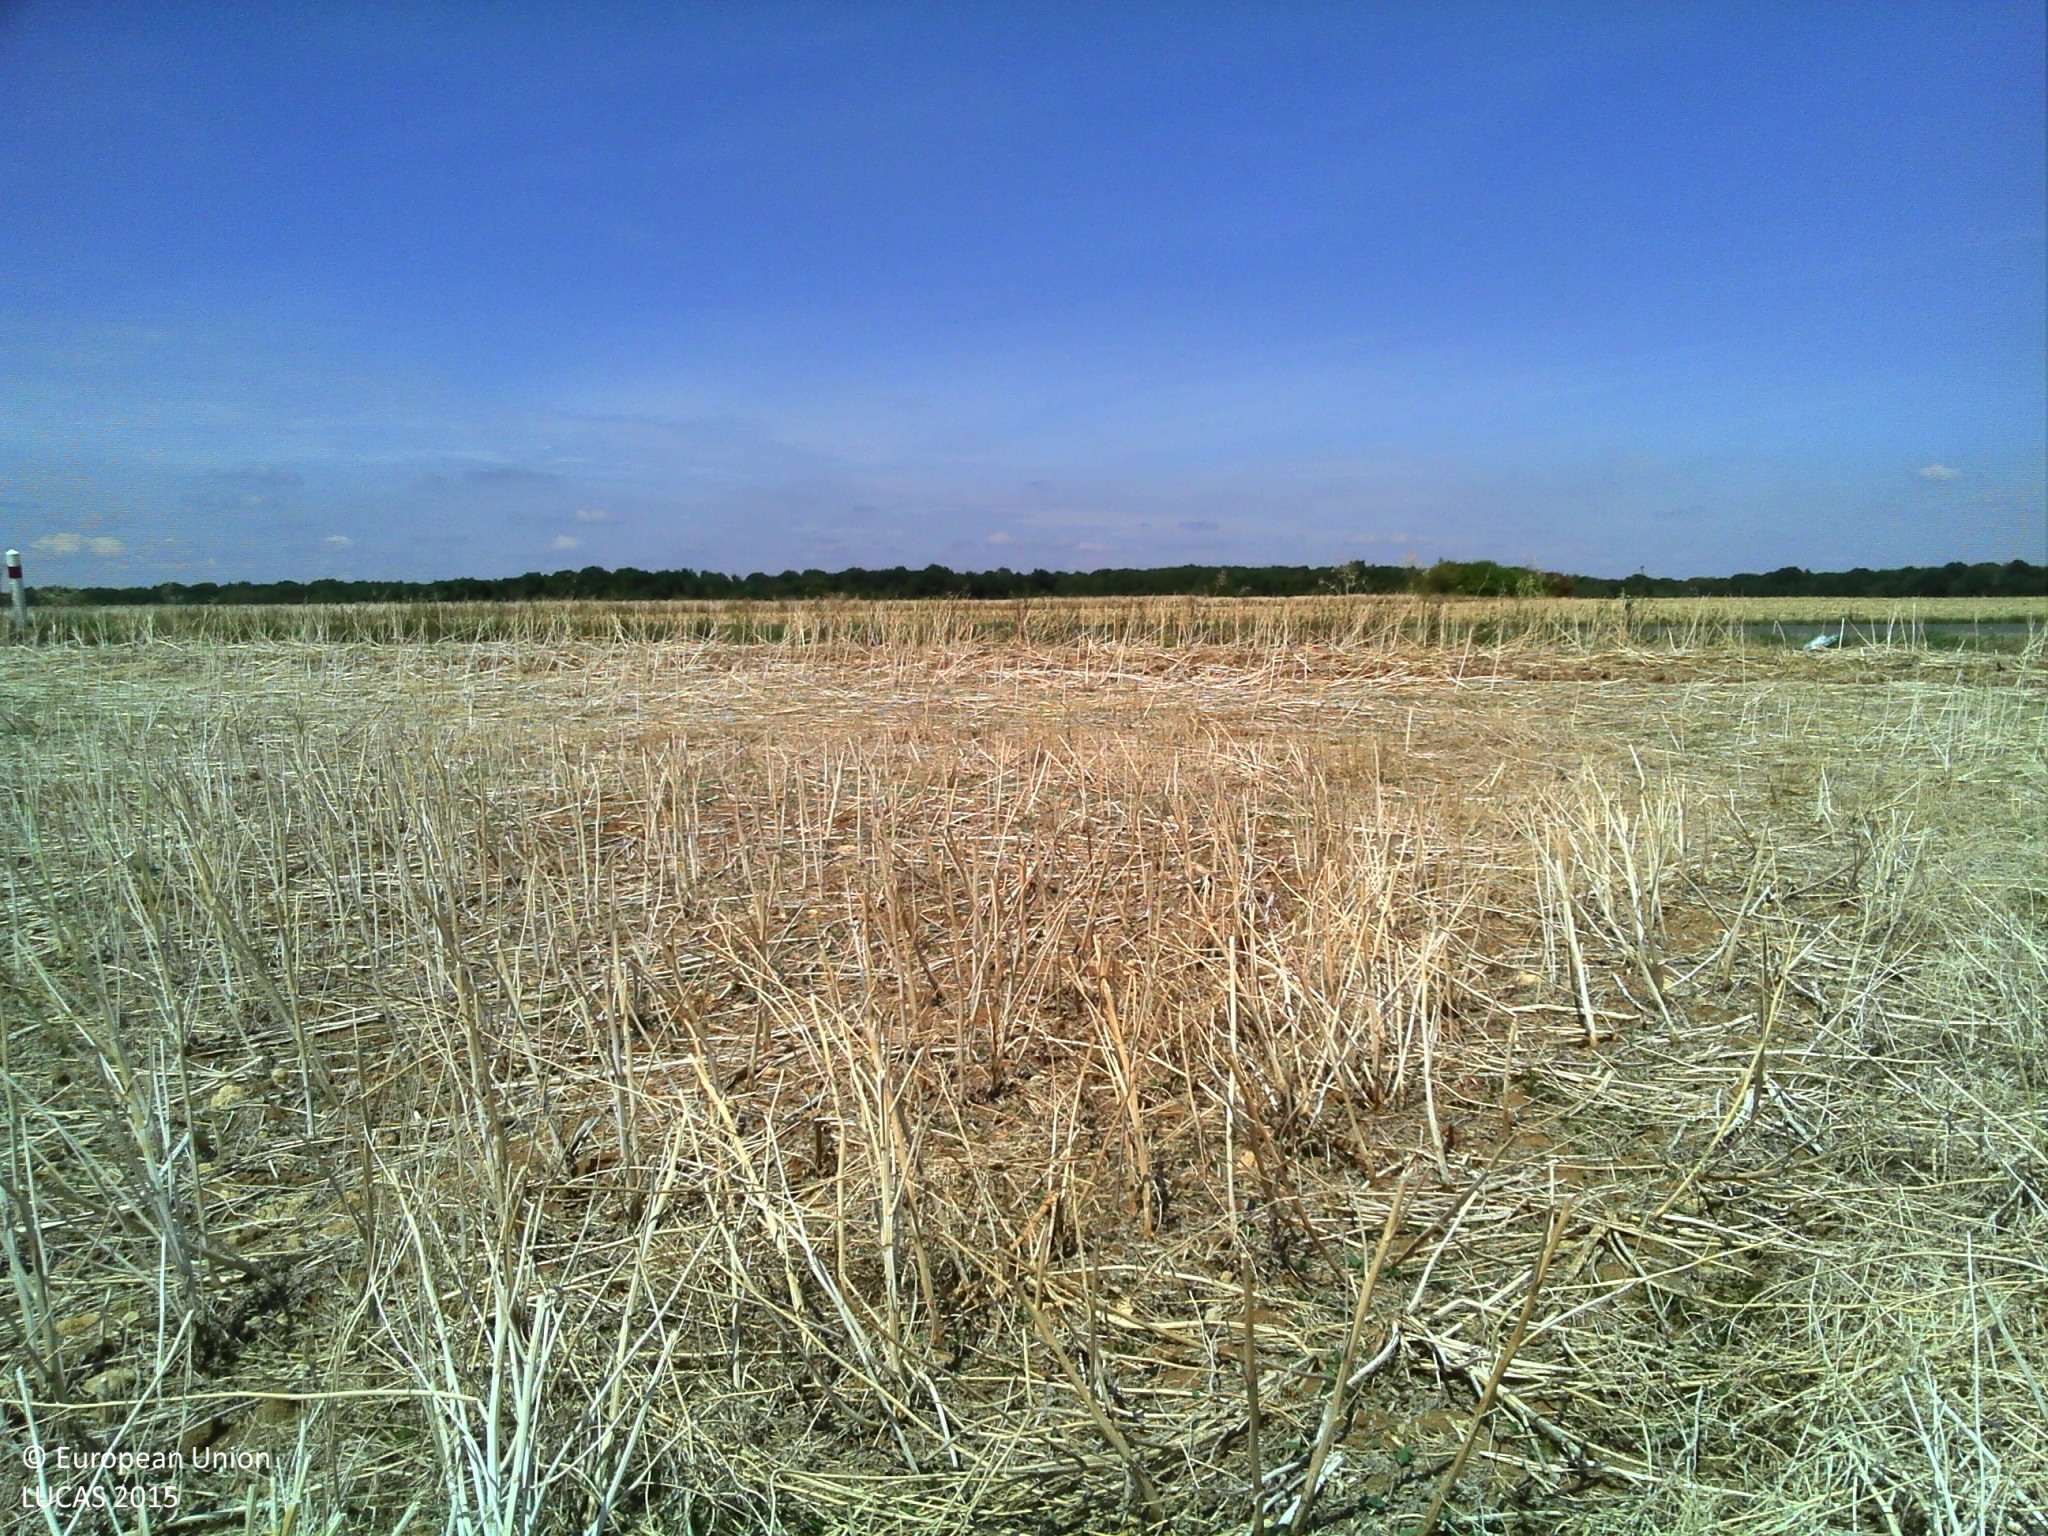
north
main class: Cropland
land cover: Rape and turnip rape
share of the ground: > 75 %
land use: Agriculture (excluding fallow land and kitchen gardens)
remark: Harvested field
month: August
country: FR
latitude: 48.2222
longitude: 2.7901
